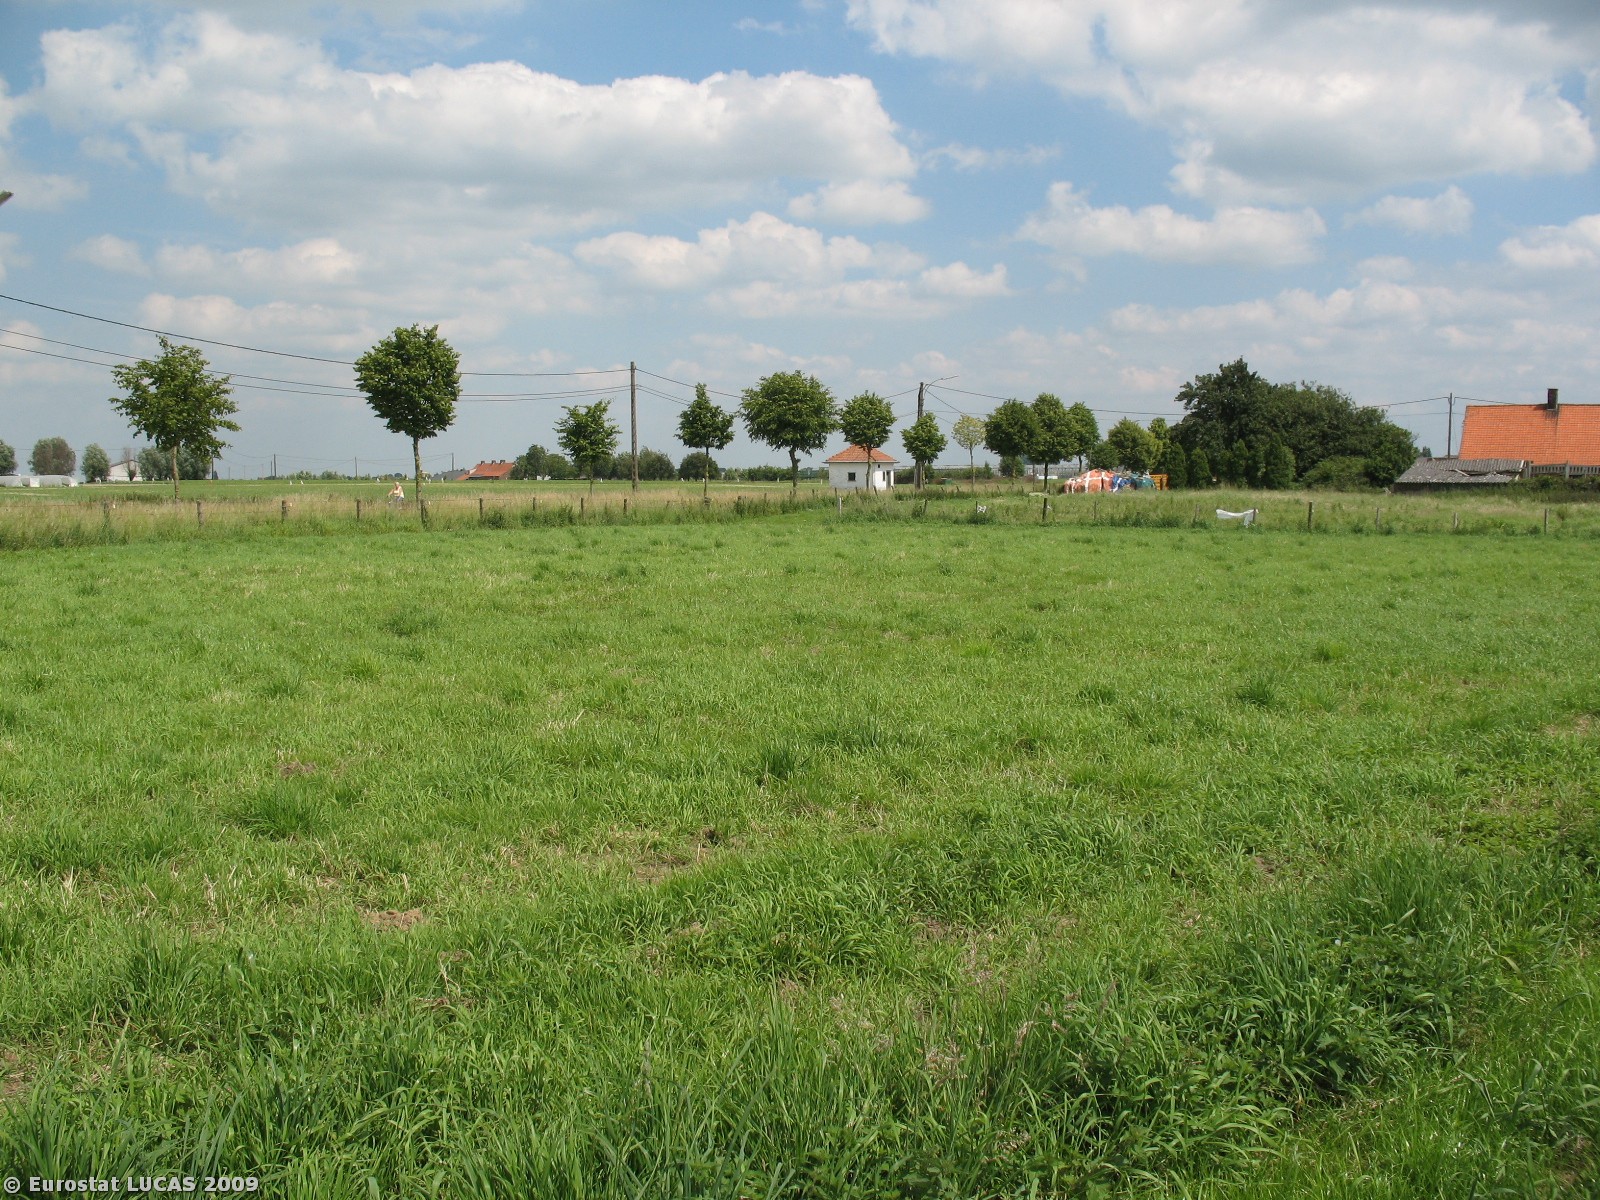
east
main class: Grassland
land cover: Grassland without tree/shrub cover
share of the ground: > 75 %
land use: Agriculture (excluding fallow land and kitchen gardens)
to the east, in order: Grassland without tree/shrub cover; Fences; Ditches and canals; Grass margins; Lines of trees; Paved roads, cycling and walking lanes; Grass margins; Electric lines; Ditches and canals; Sugar beet
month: June
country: BE
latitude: 51.0143
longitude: 3.2775
